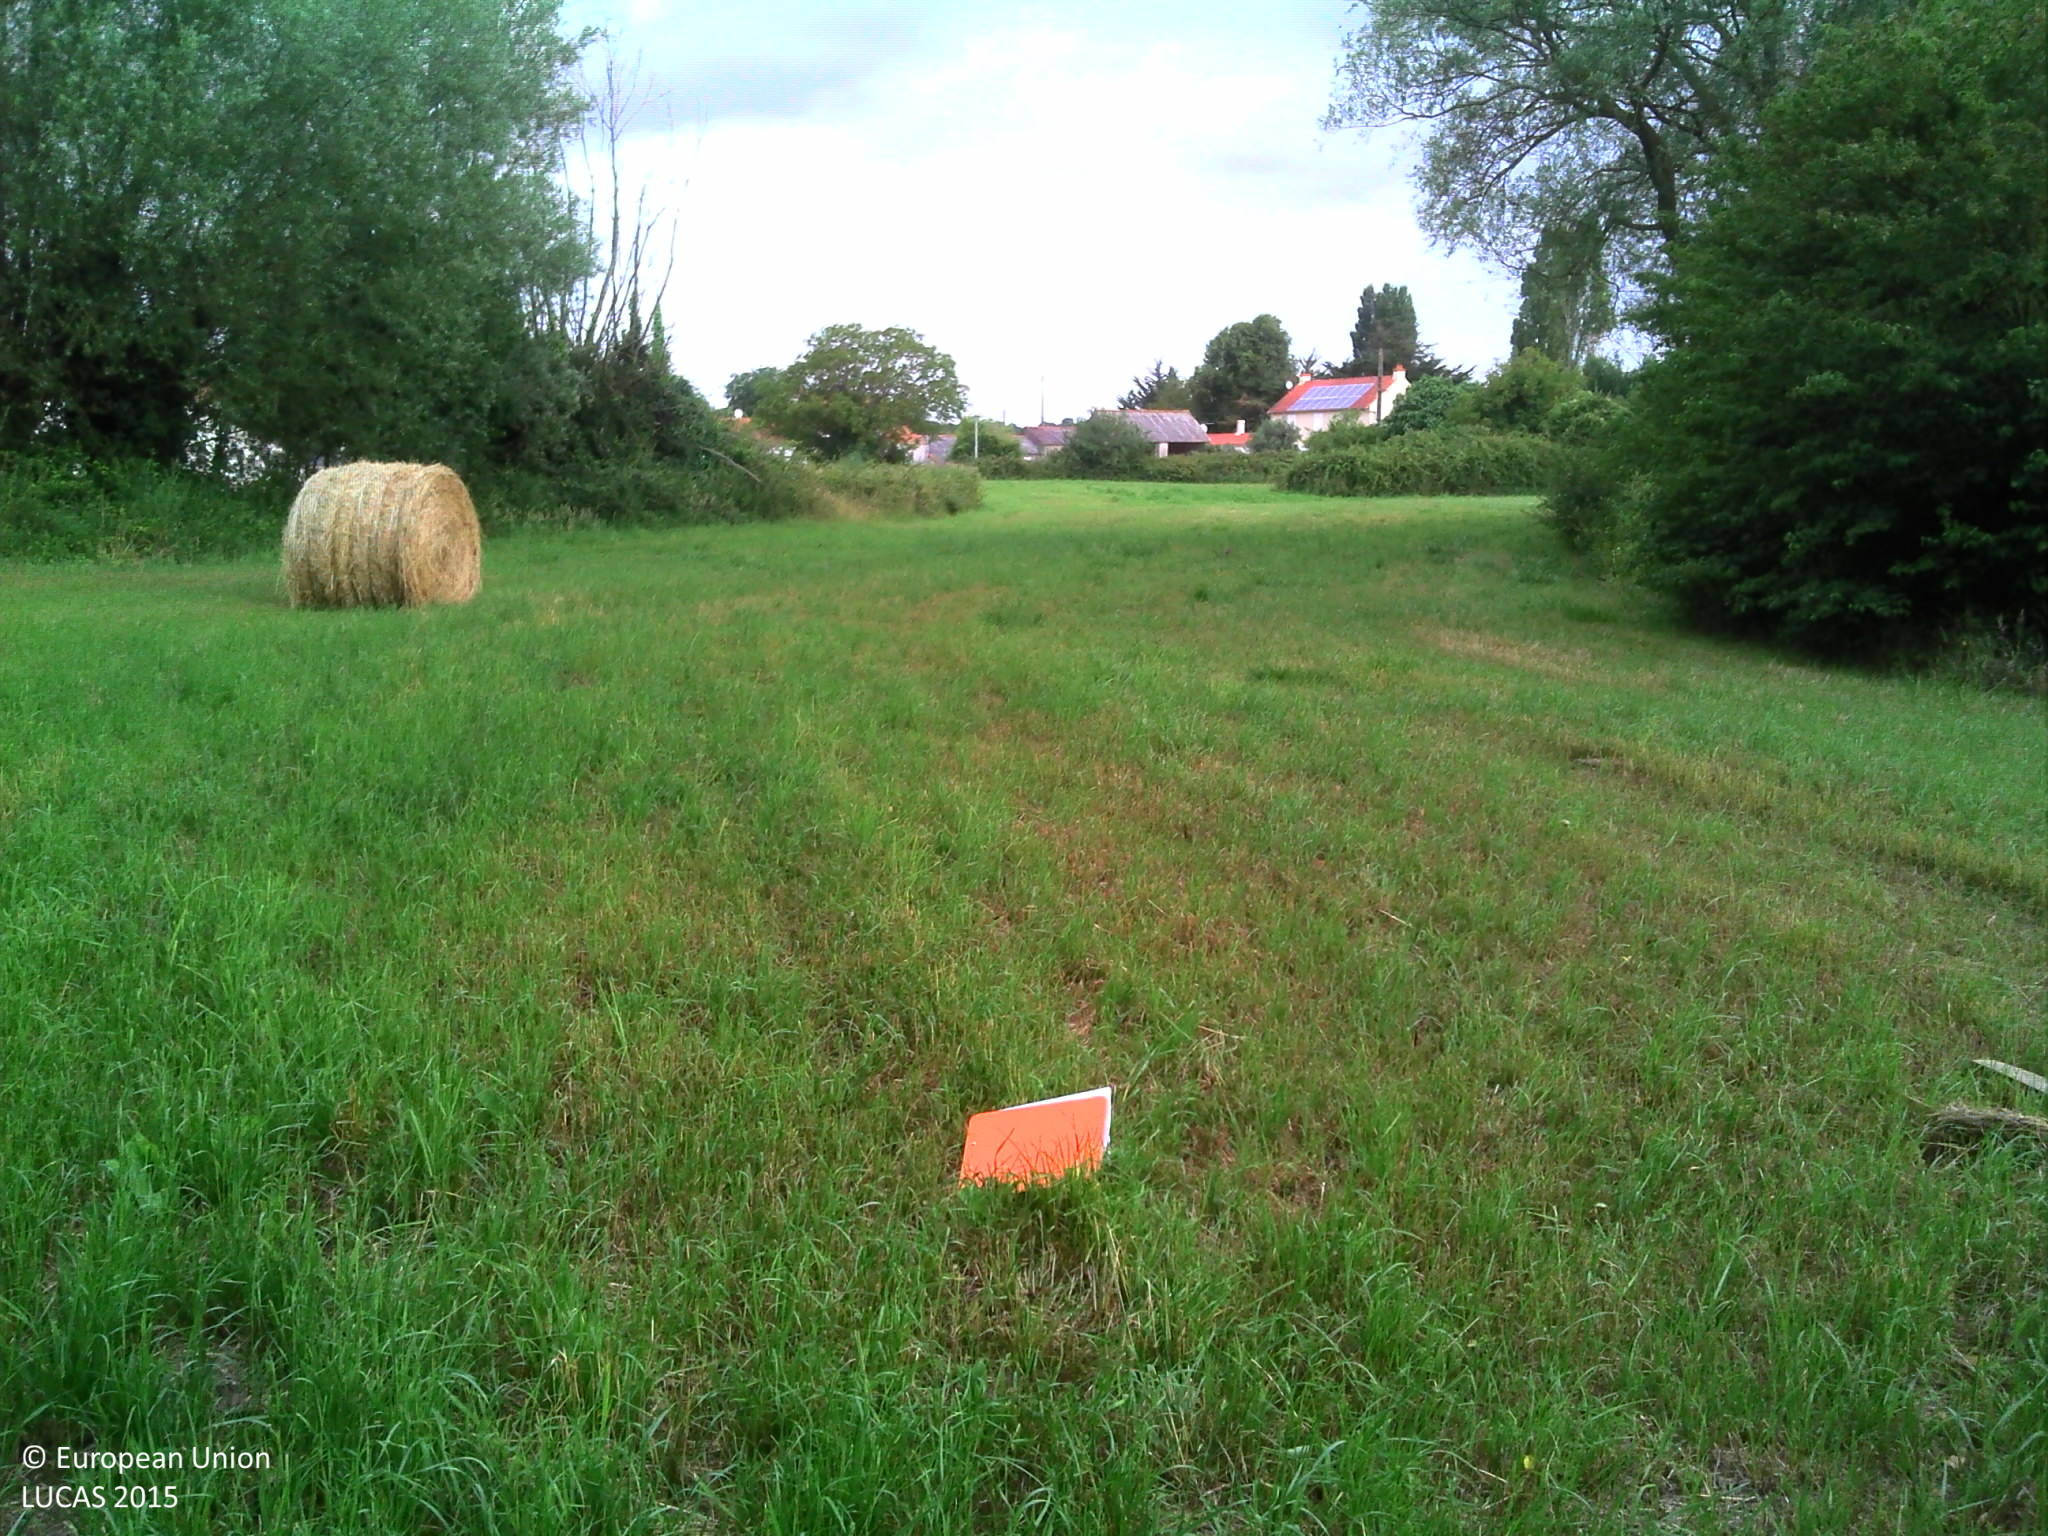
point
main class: Cropland
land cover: Temporary grasslands
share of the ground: > 75 %
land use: Agriculture (excluding fallow land and kitchen gardens)
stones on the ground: < 10 %
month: July
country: FR
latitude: 47.0036
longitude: -1.8156
